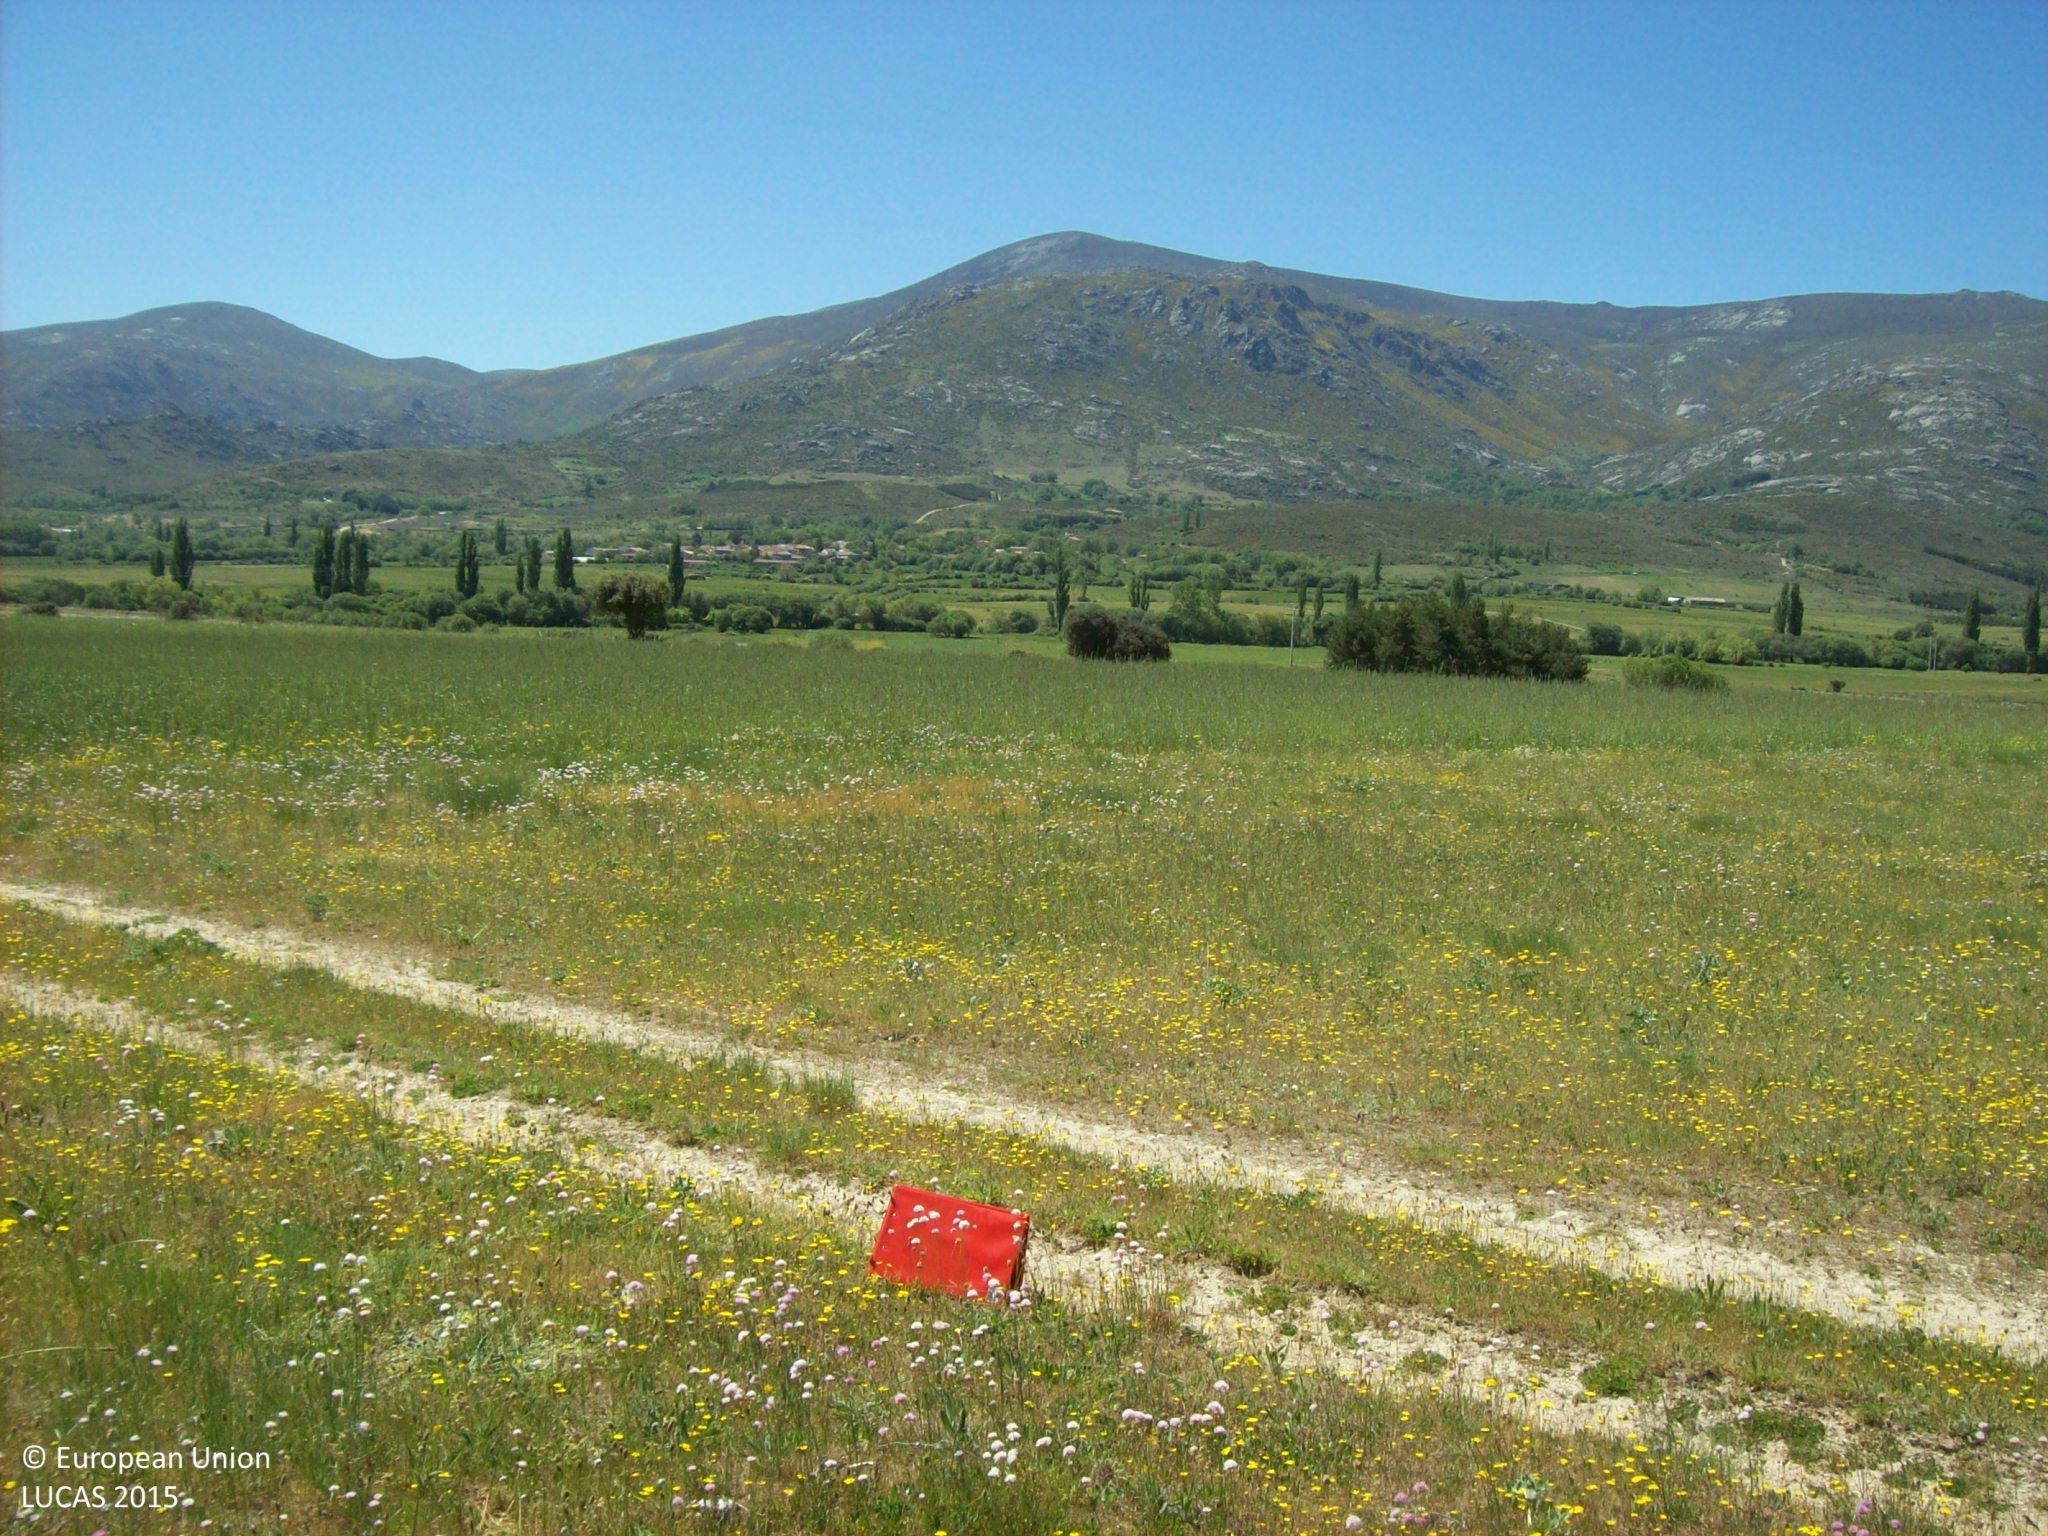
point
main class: Grassland
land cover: Grassland without tree/shrub cover
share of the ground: > 75 %
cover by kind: herbaceous plants 90 %
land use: Abandoned areas
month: May
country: ES
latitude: 40.5645
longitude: -5.0725
